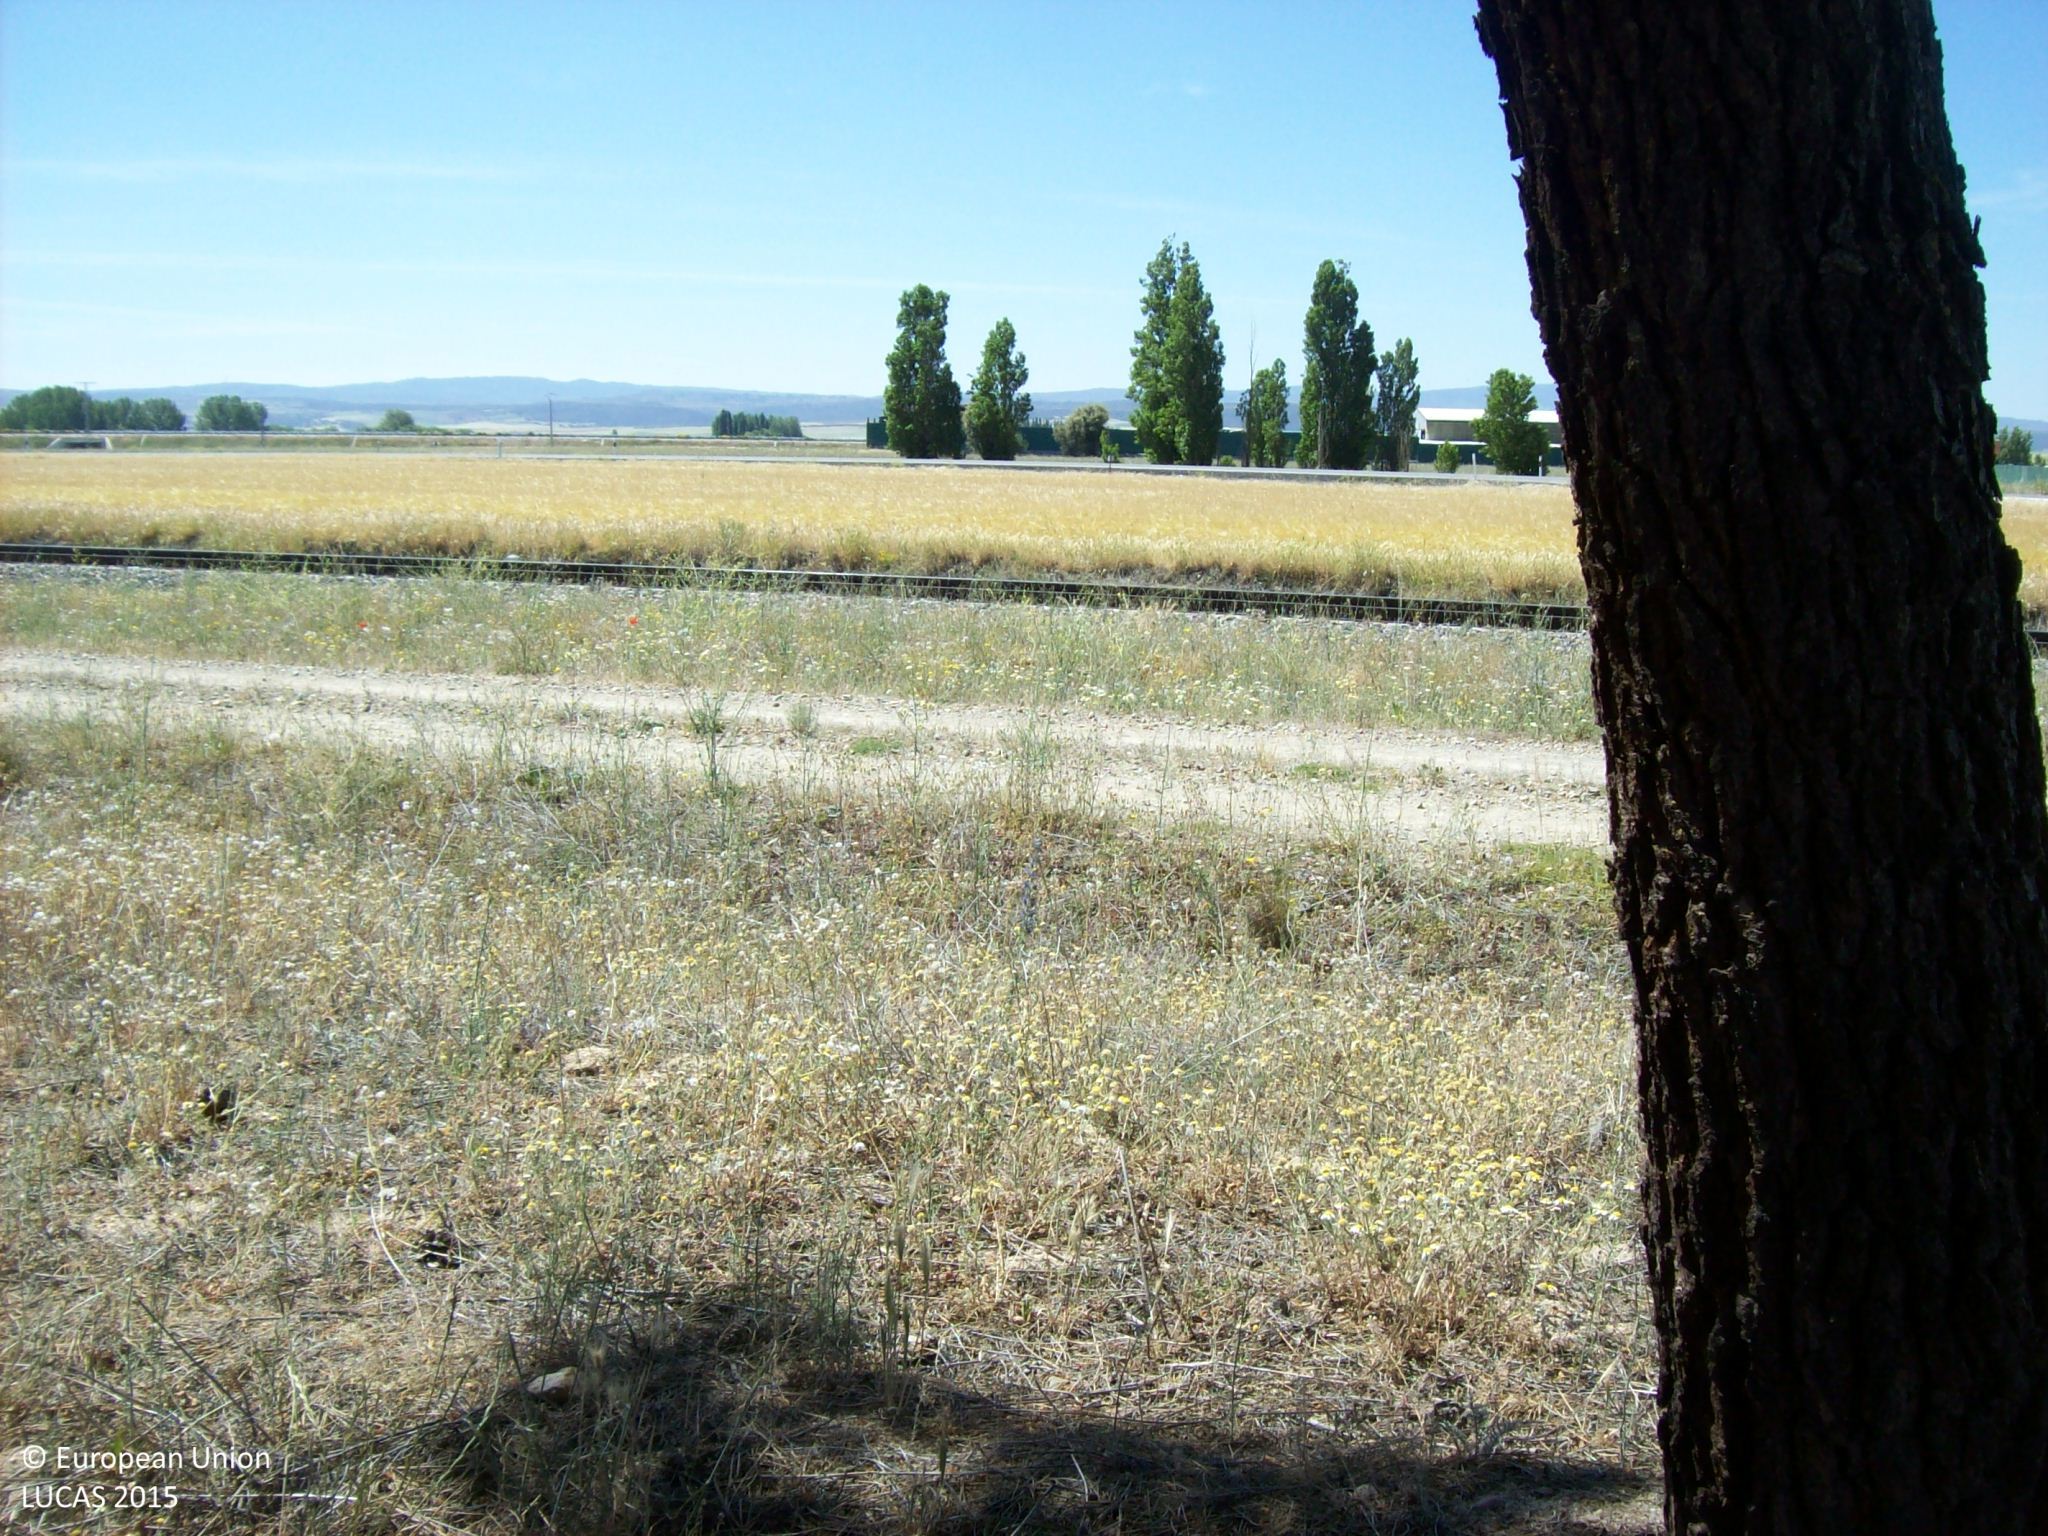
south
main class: Woodland
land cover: Pine dominated coniferous woodland
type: coniferous forest of the mediterranean region
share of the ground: 25 - 50 %
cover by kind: unconsolidated bare surface 50 %, coniferous forest trees 30 %, herbaceous plants 10 %
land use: Forestry
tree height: < 5 m
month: May
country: ES
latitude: 40.8125
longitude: -4.8915
